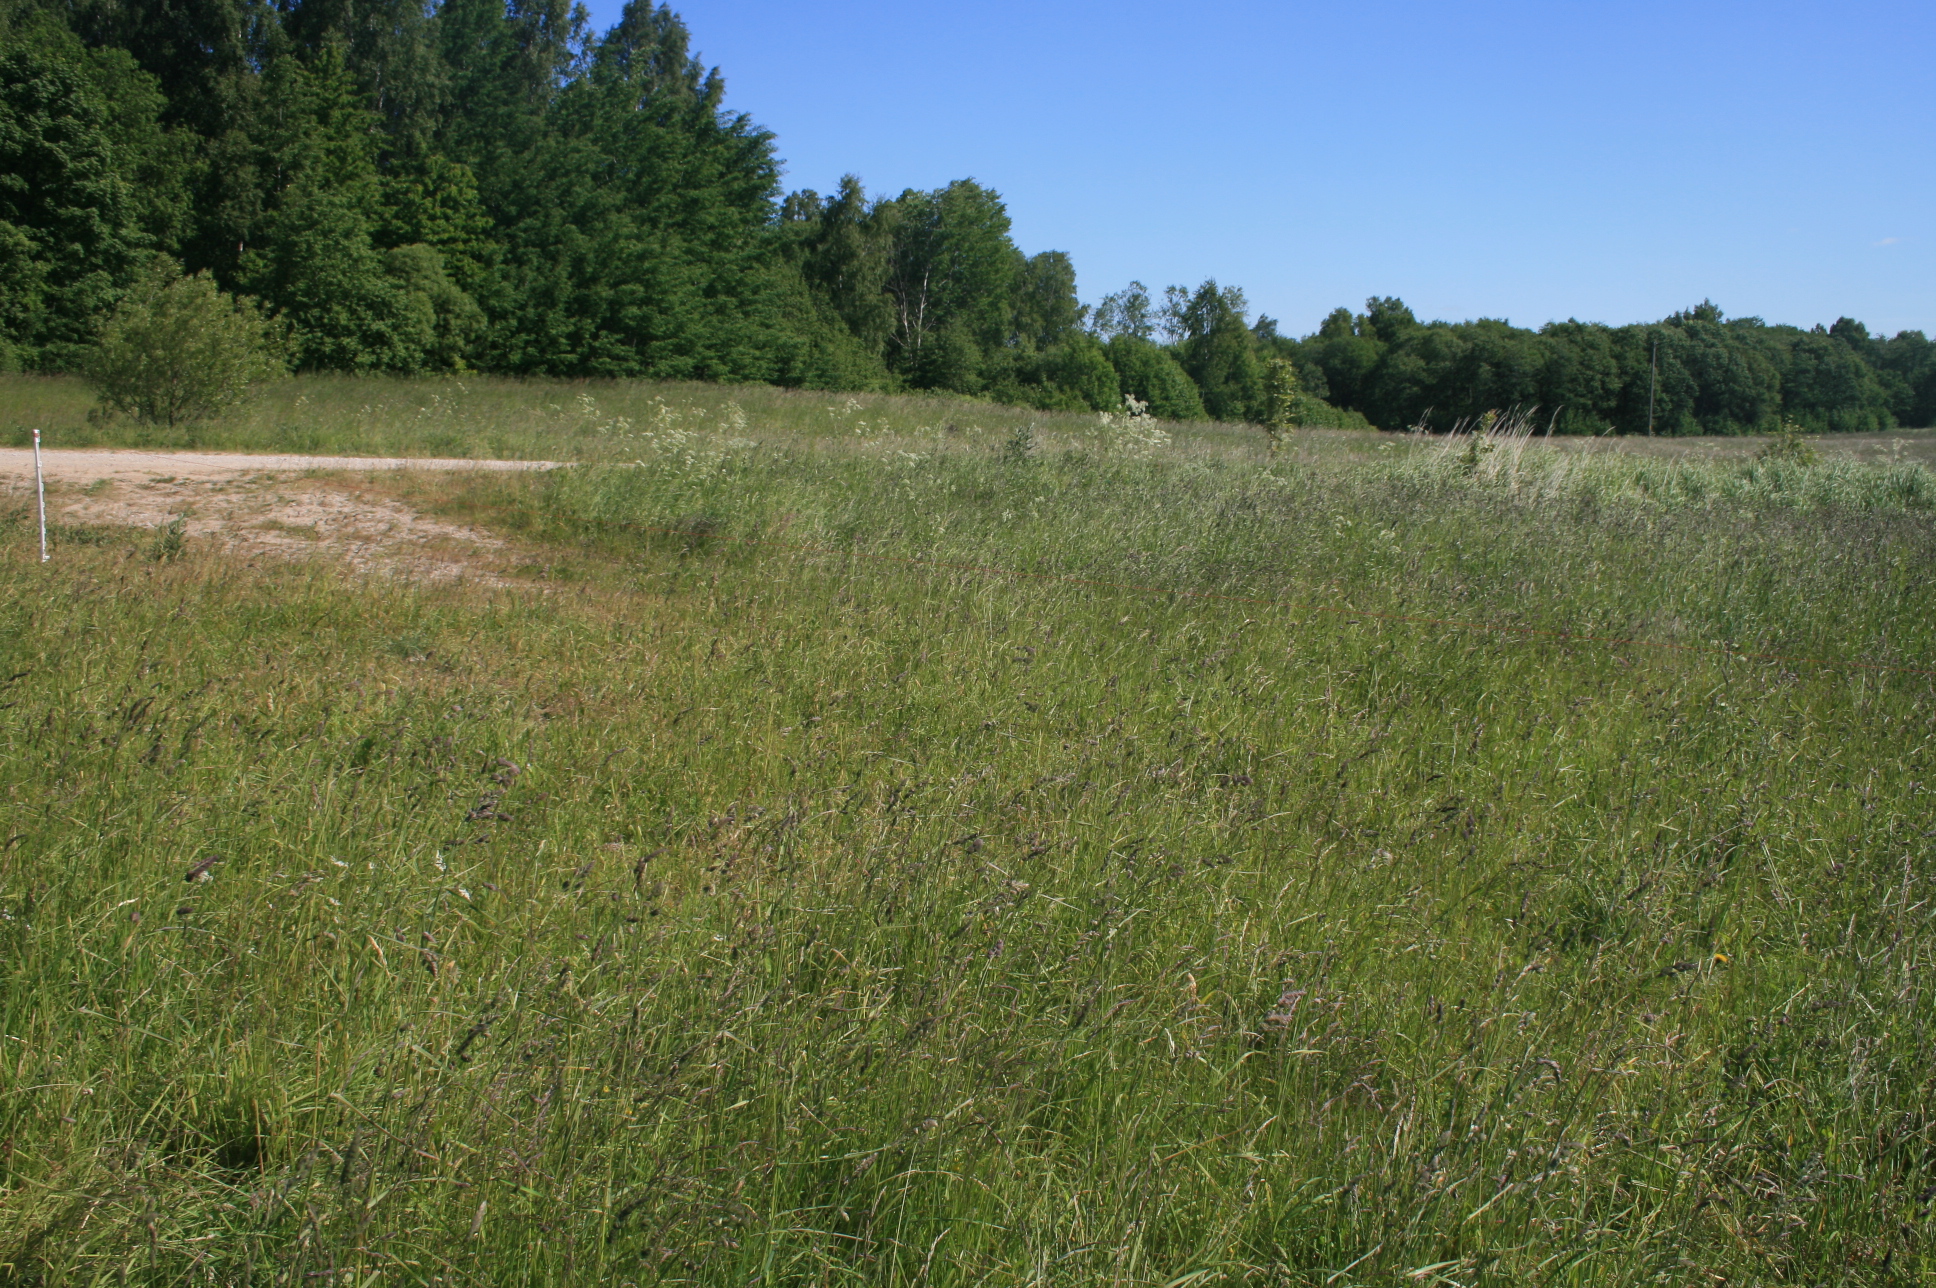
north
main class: Grassland
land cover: Grassland without tree/shrub cover
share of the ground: > 75 %
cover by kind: herbaceous plants 100 %
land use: Agriculture (excluding fallow land and kitchen gardens)
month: June
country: LT
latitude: 55.9420
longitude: 22.2719
